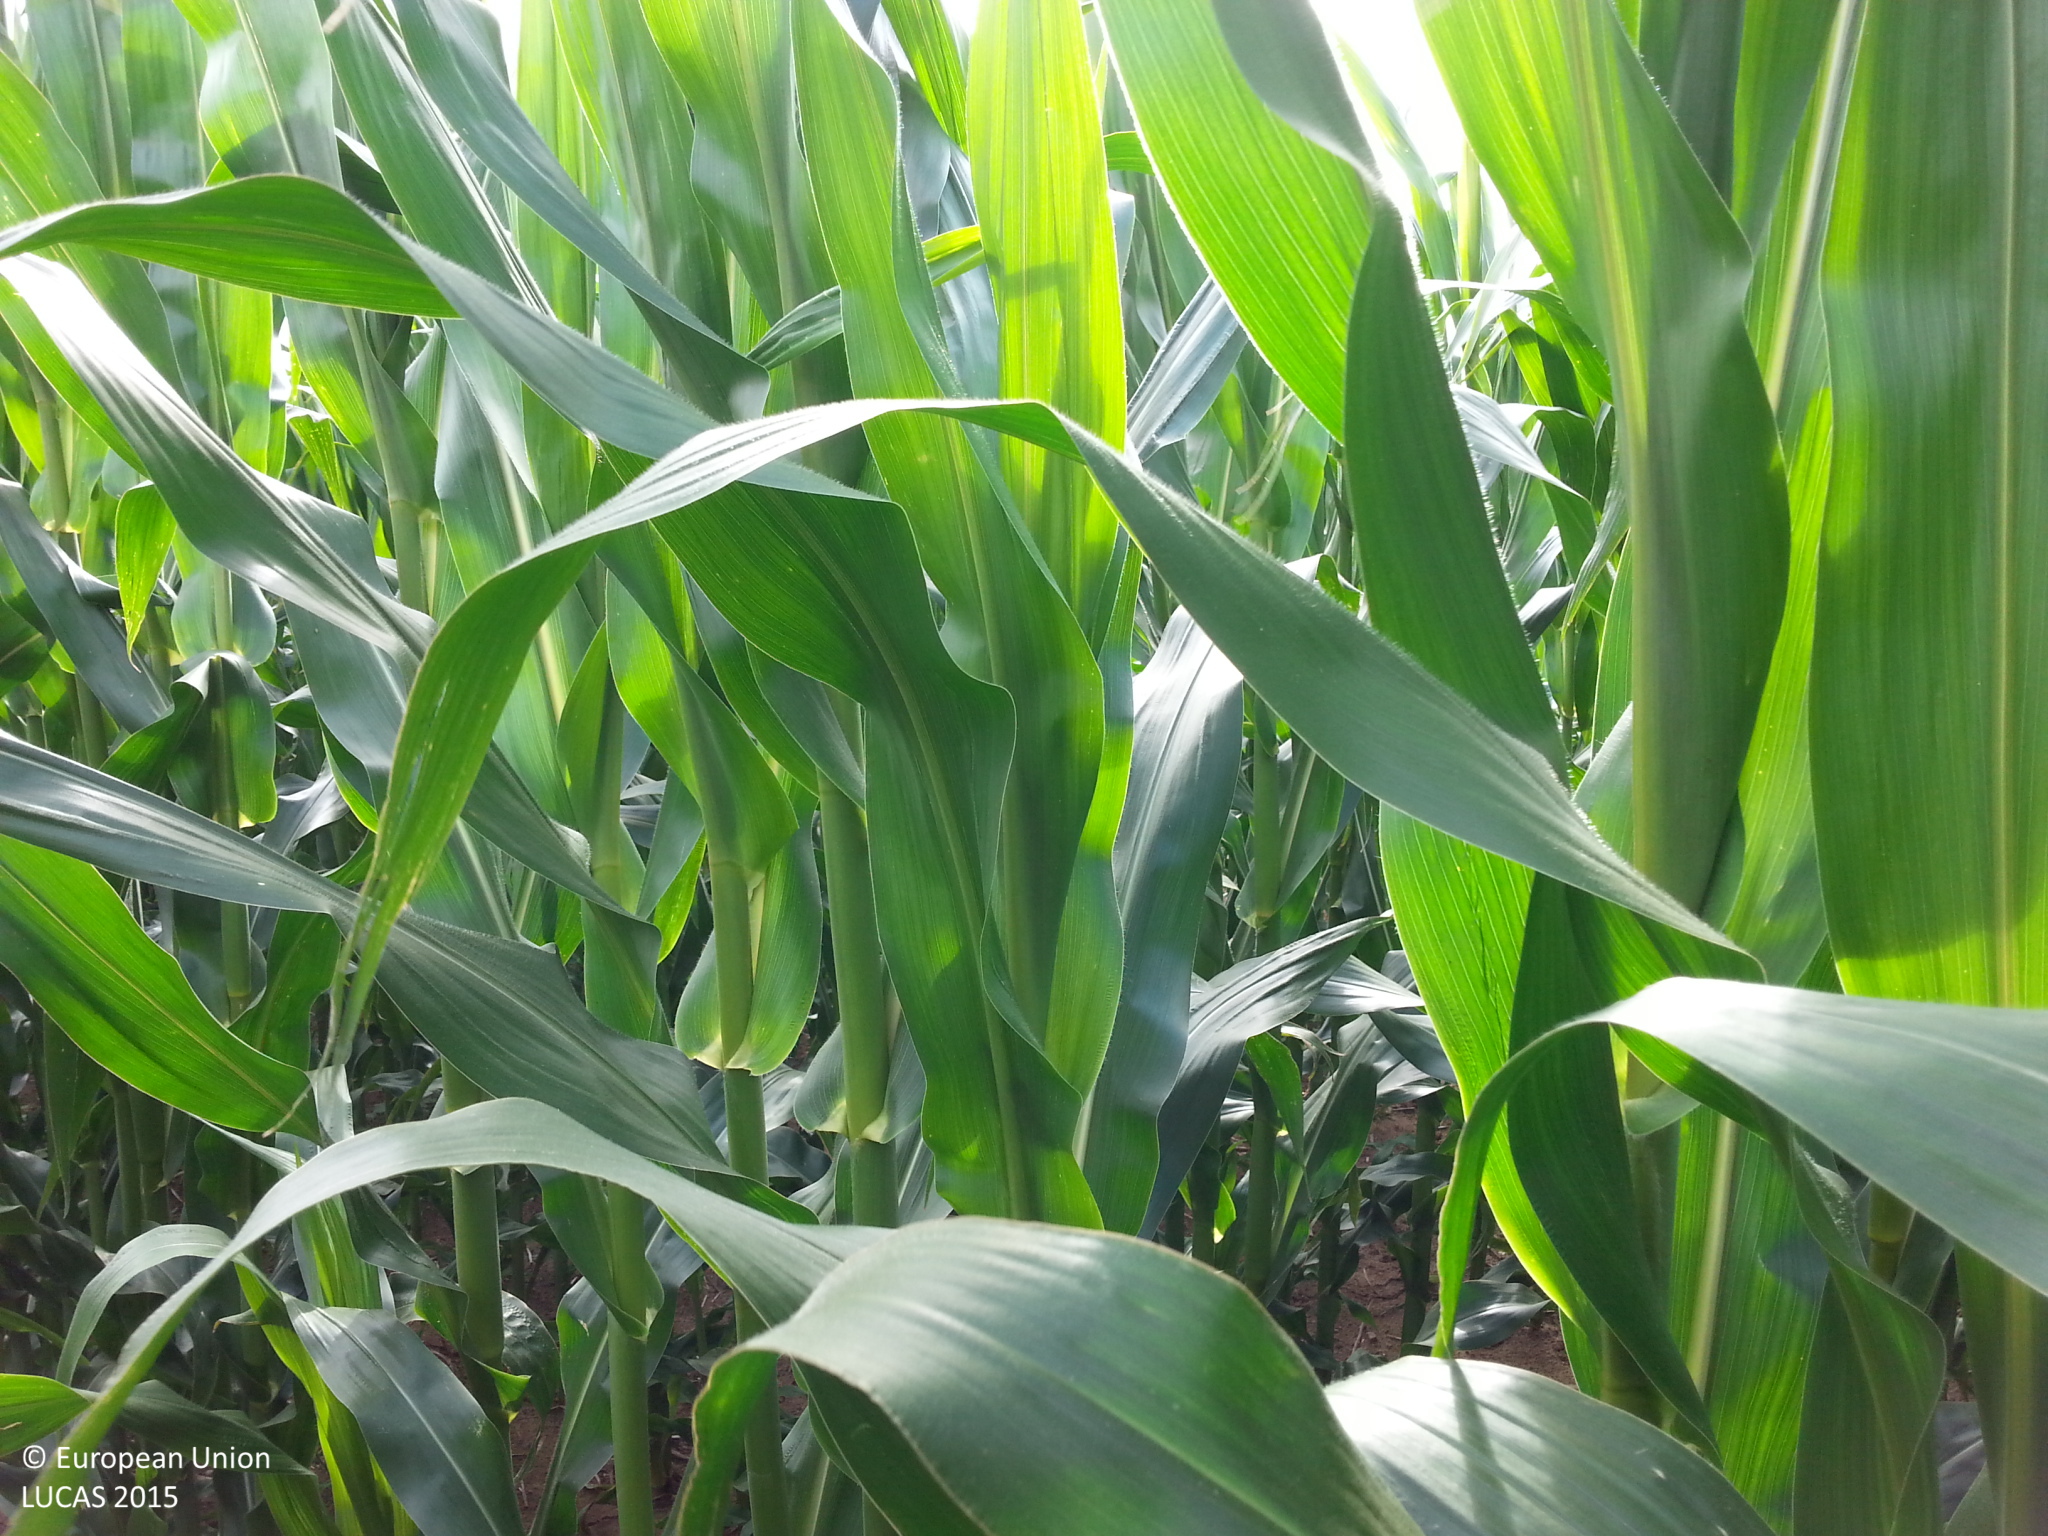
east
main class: Cropland
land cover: Maize
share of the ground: > 75 %
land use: Agriculture (excluding fallow land and kitchen gardens)
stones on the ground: < 10 %
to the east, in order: Maize
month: July
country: DE
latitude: 53.2155
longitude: 12.4404
